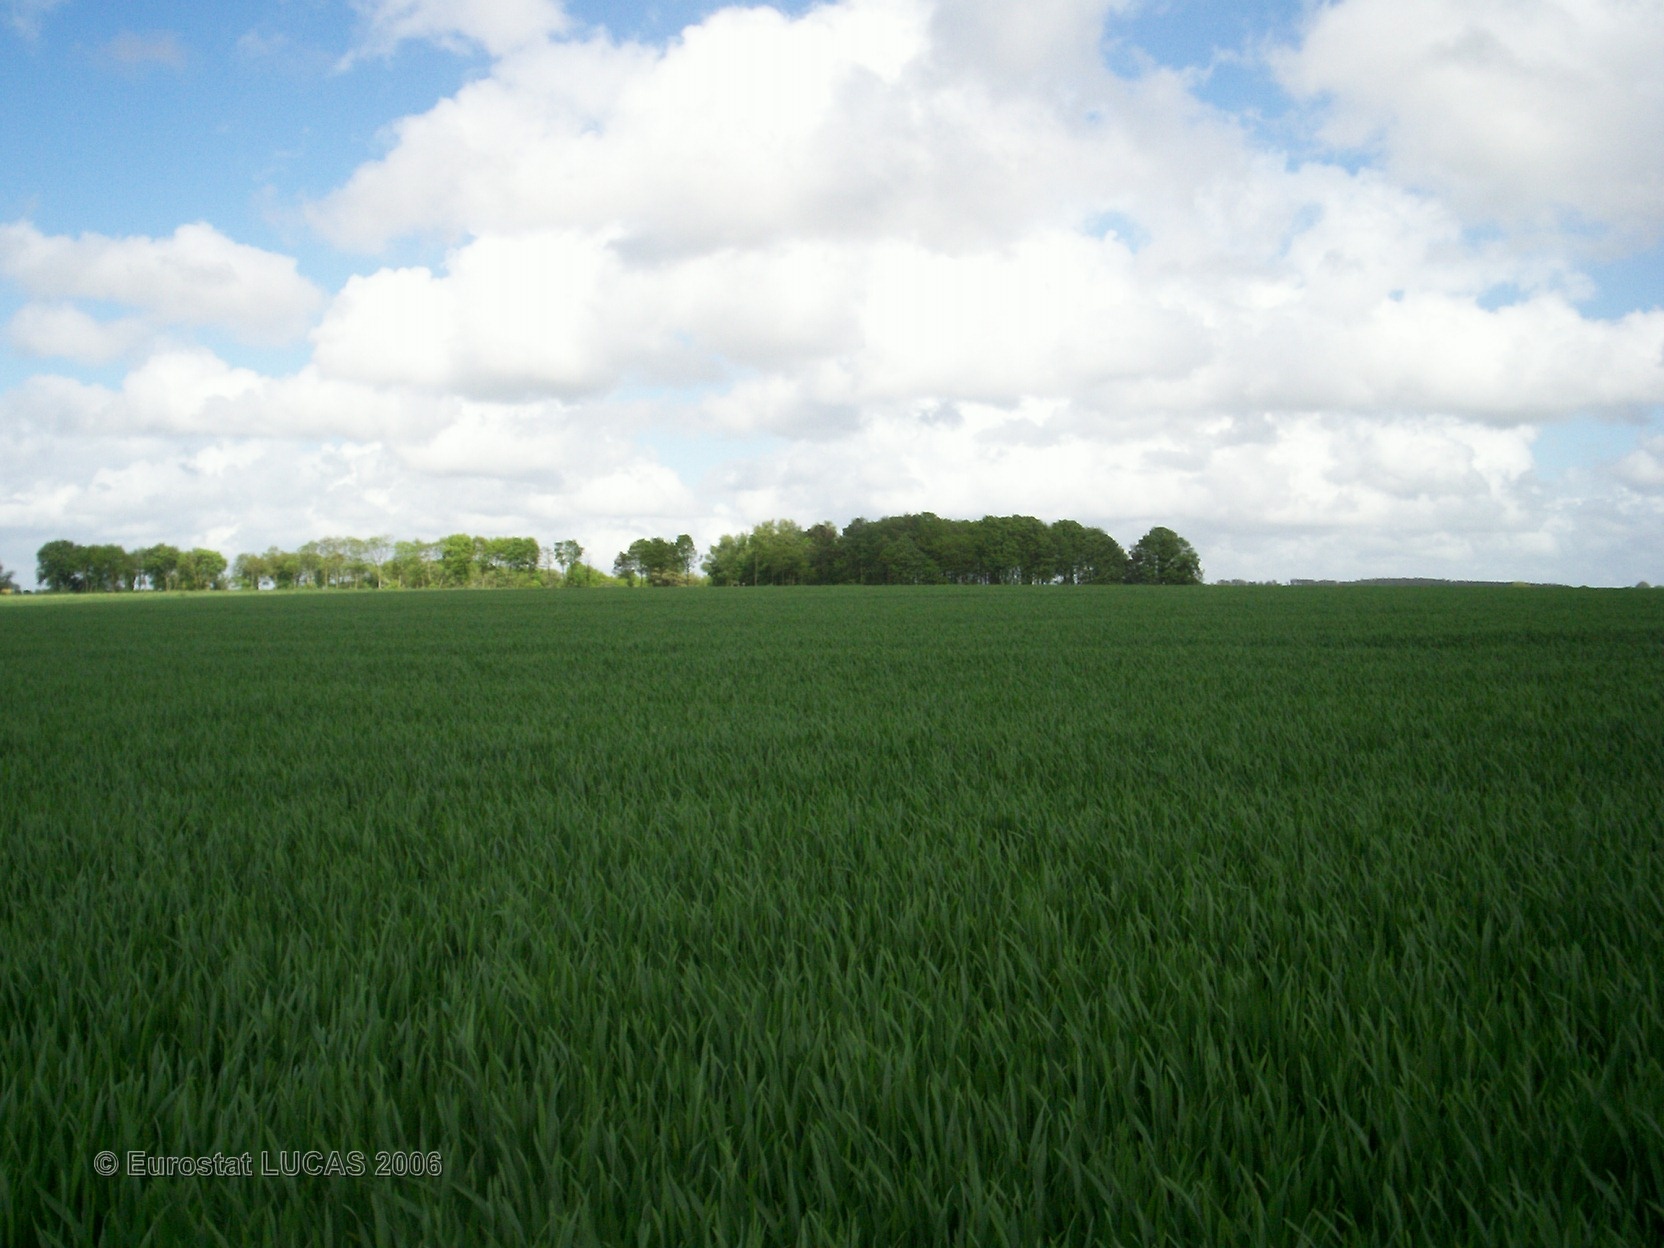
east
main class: Cropland
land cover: Common wheat
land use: Agriculture (excluding fallow land and kitchen gardens)
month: May
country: FR
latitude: 47.9008
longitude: -2.7308
